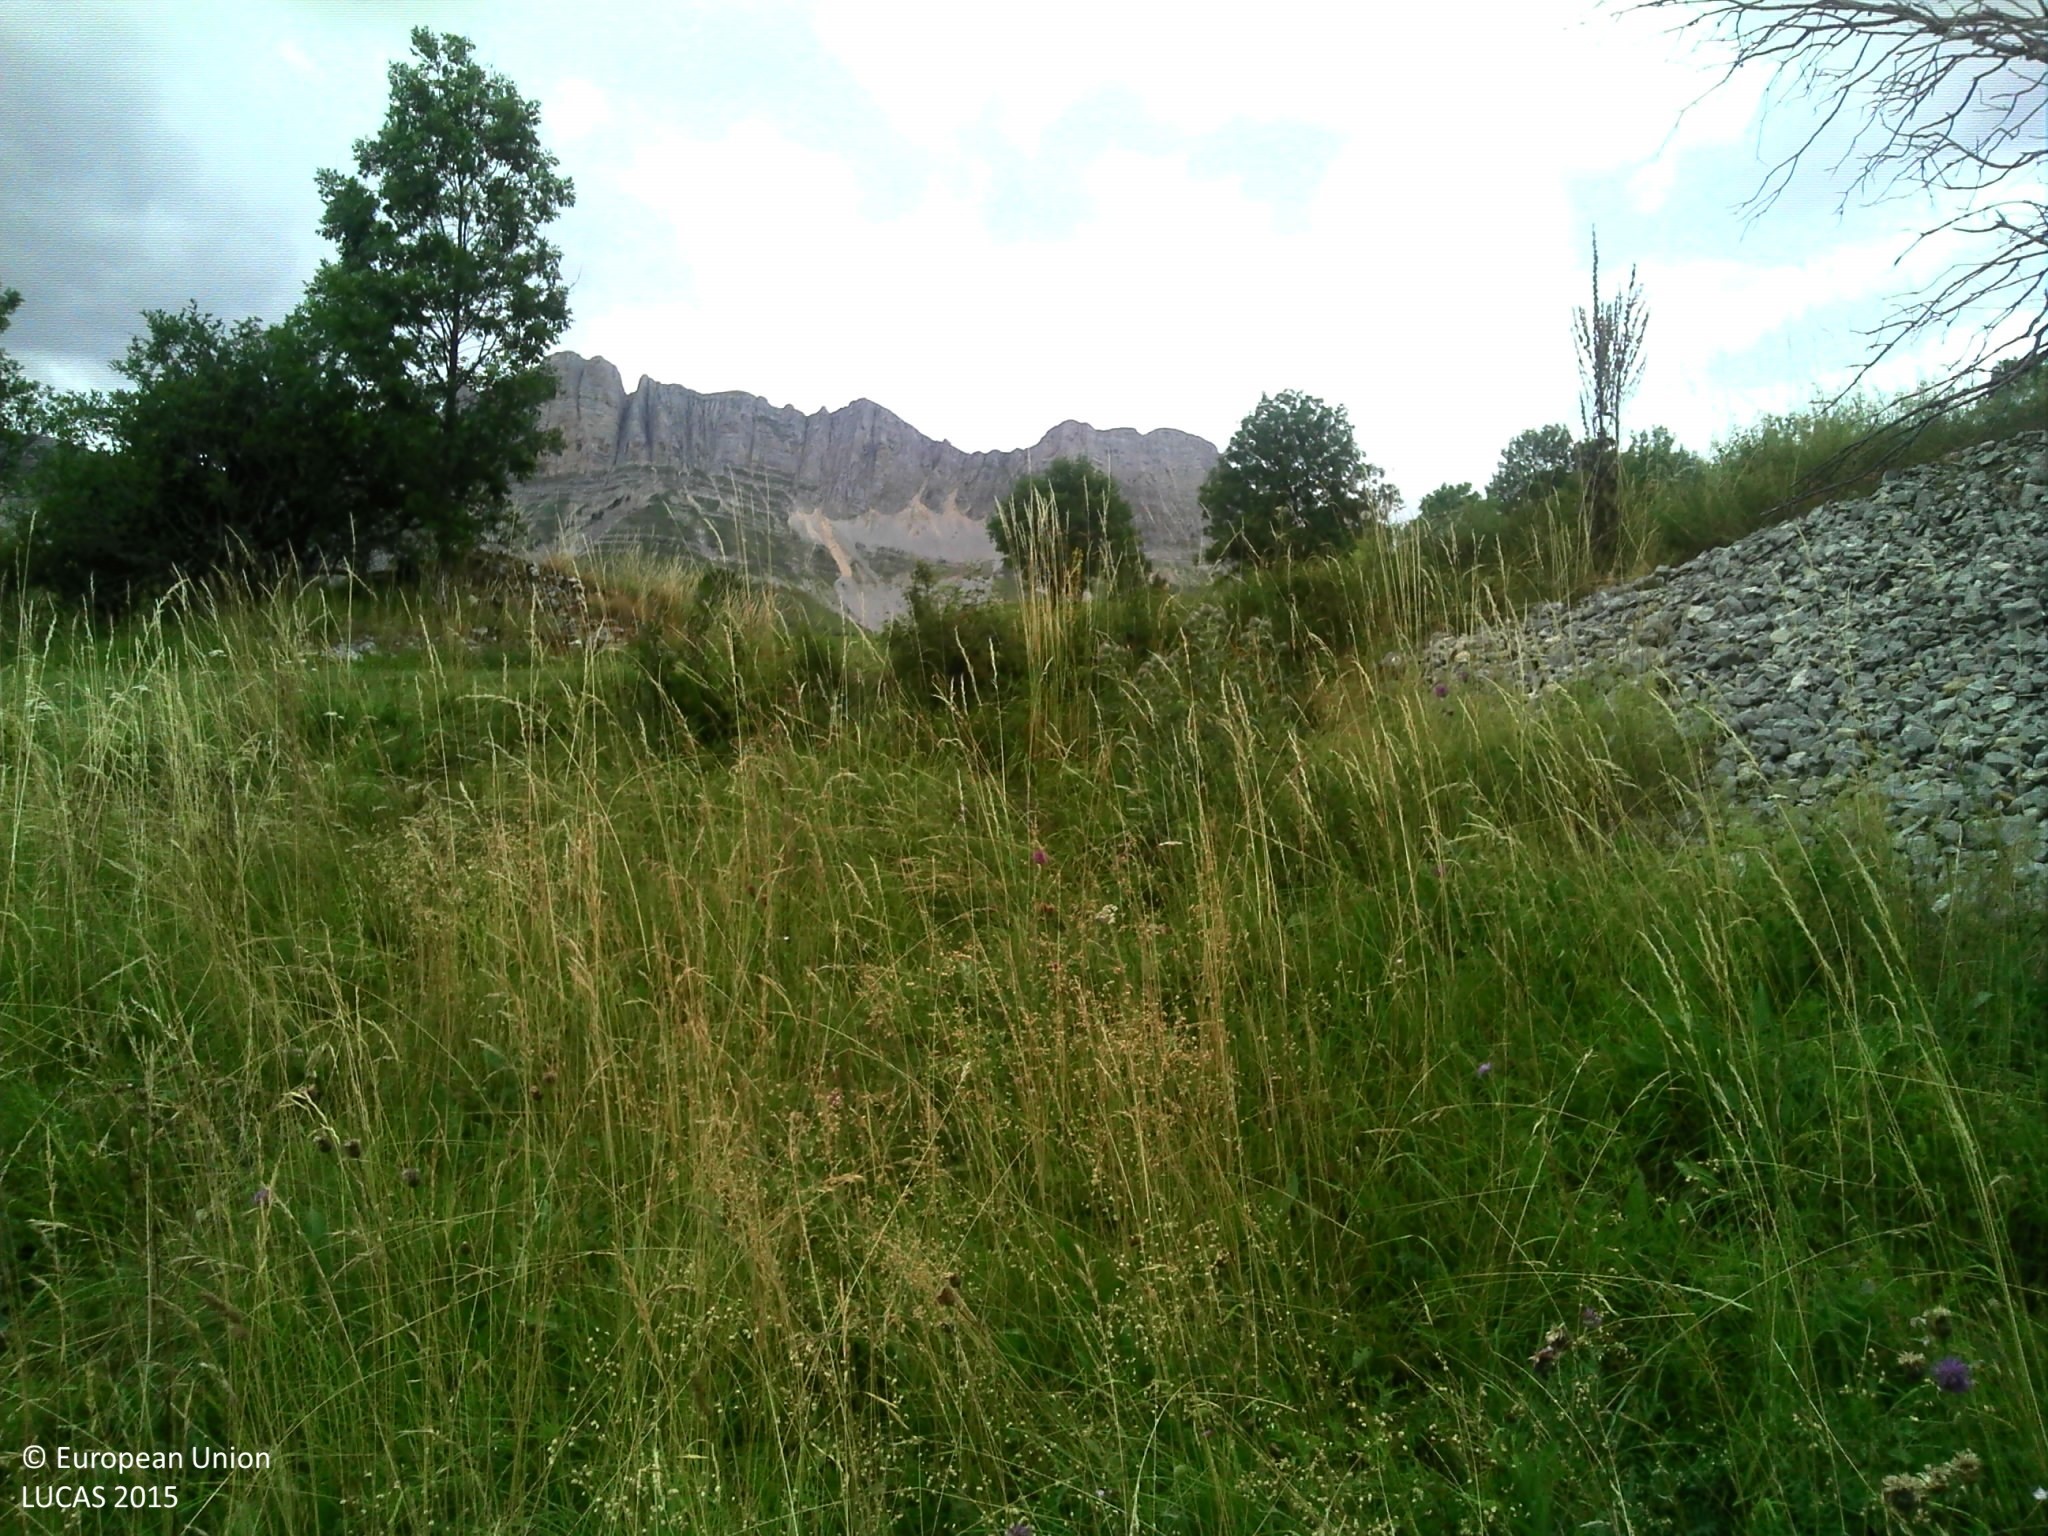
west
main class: Grassland
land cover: Grassland with sparse tree/shrub cover
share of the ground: > 75 %
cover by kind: herbaceous plants 85 %, coniferous forest trees 5 %, shrubs 5 %, consolidated bare surface 5 %
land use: Agriculture (excluding fallow land and kitchen gardens)
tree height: < 5 m
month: July
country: FR
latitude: 44.9057
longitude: 5.5606
